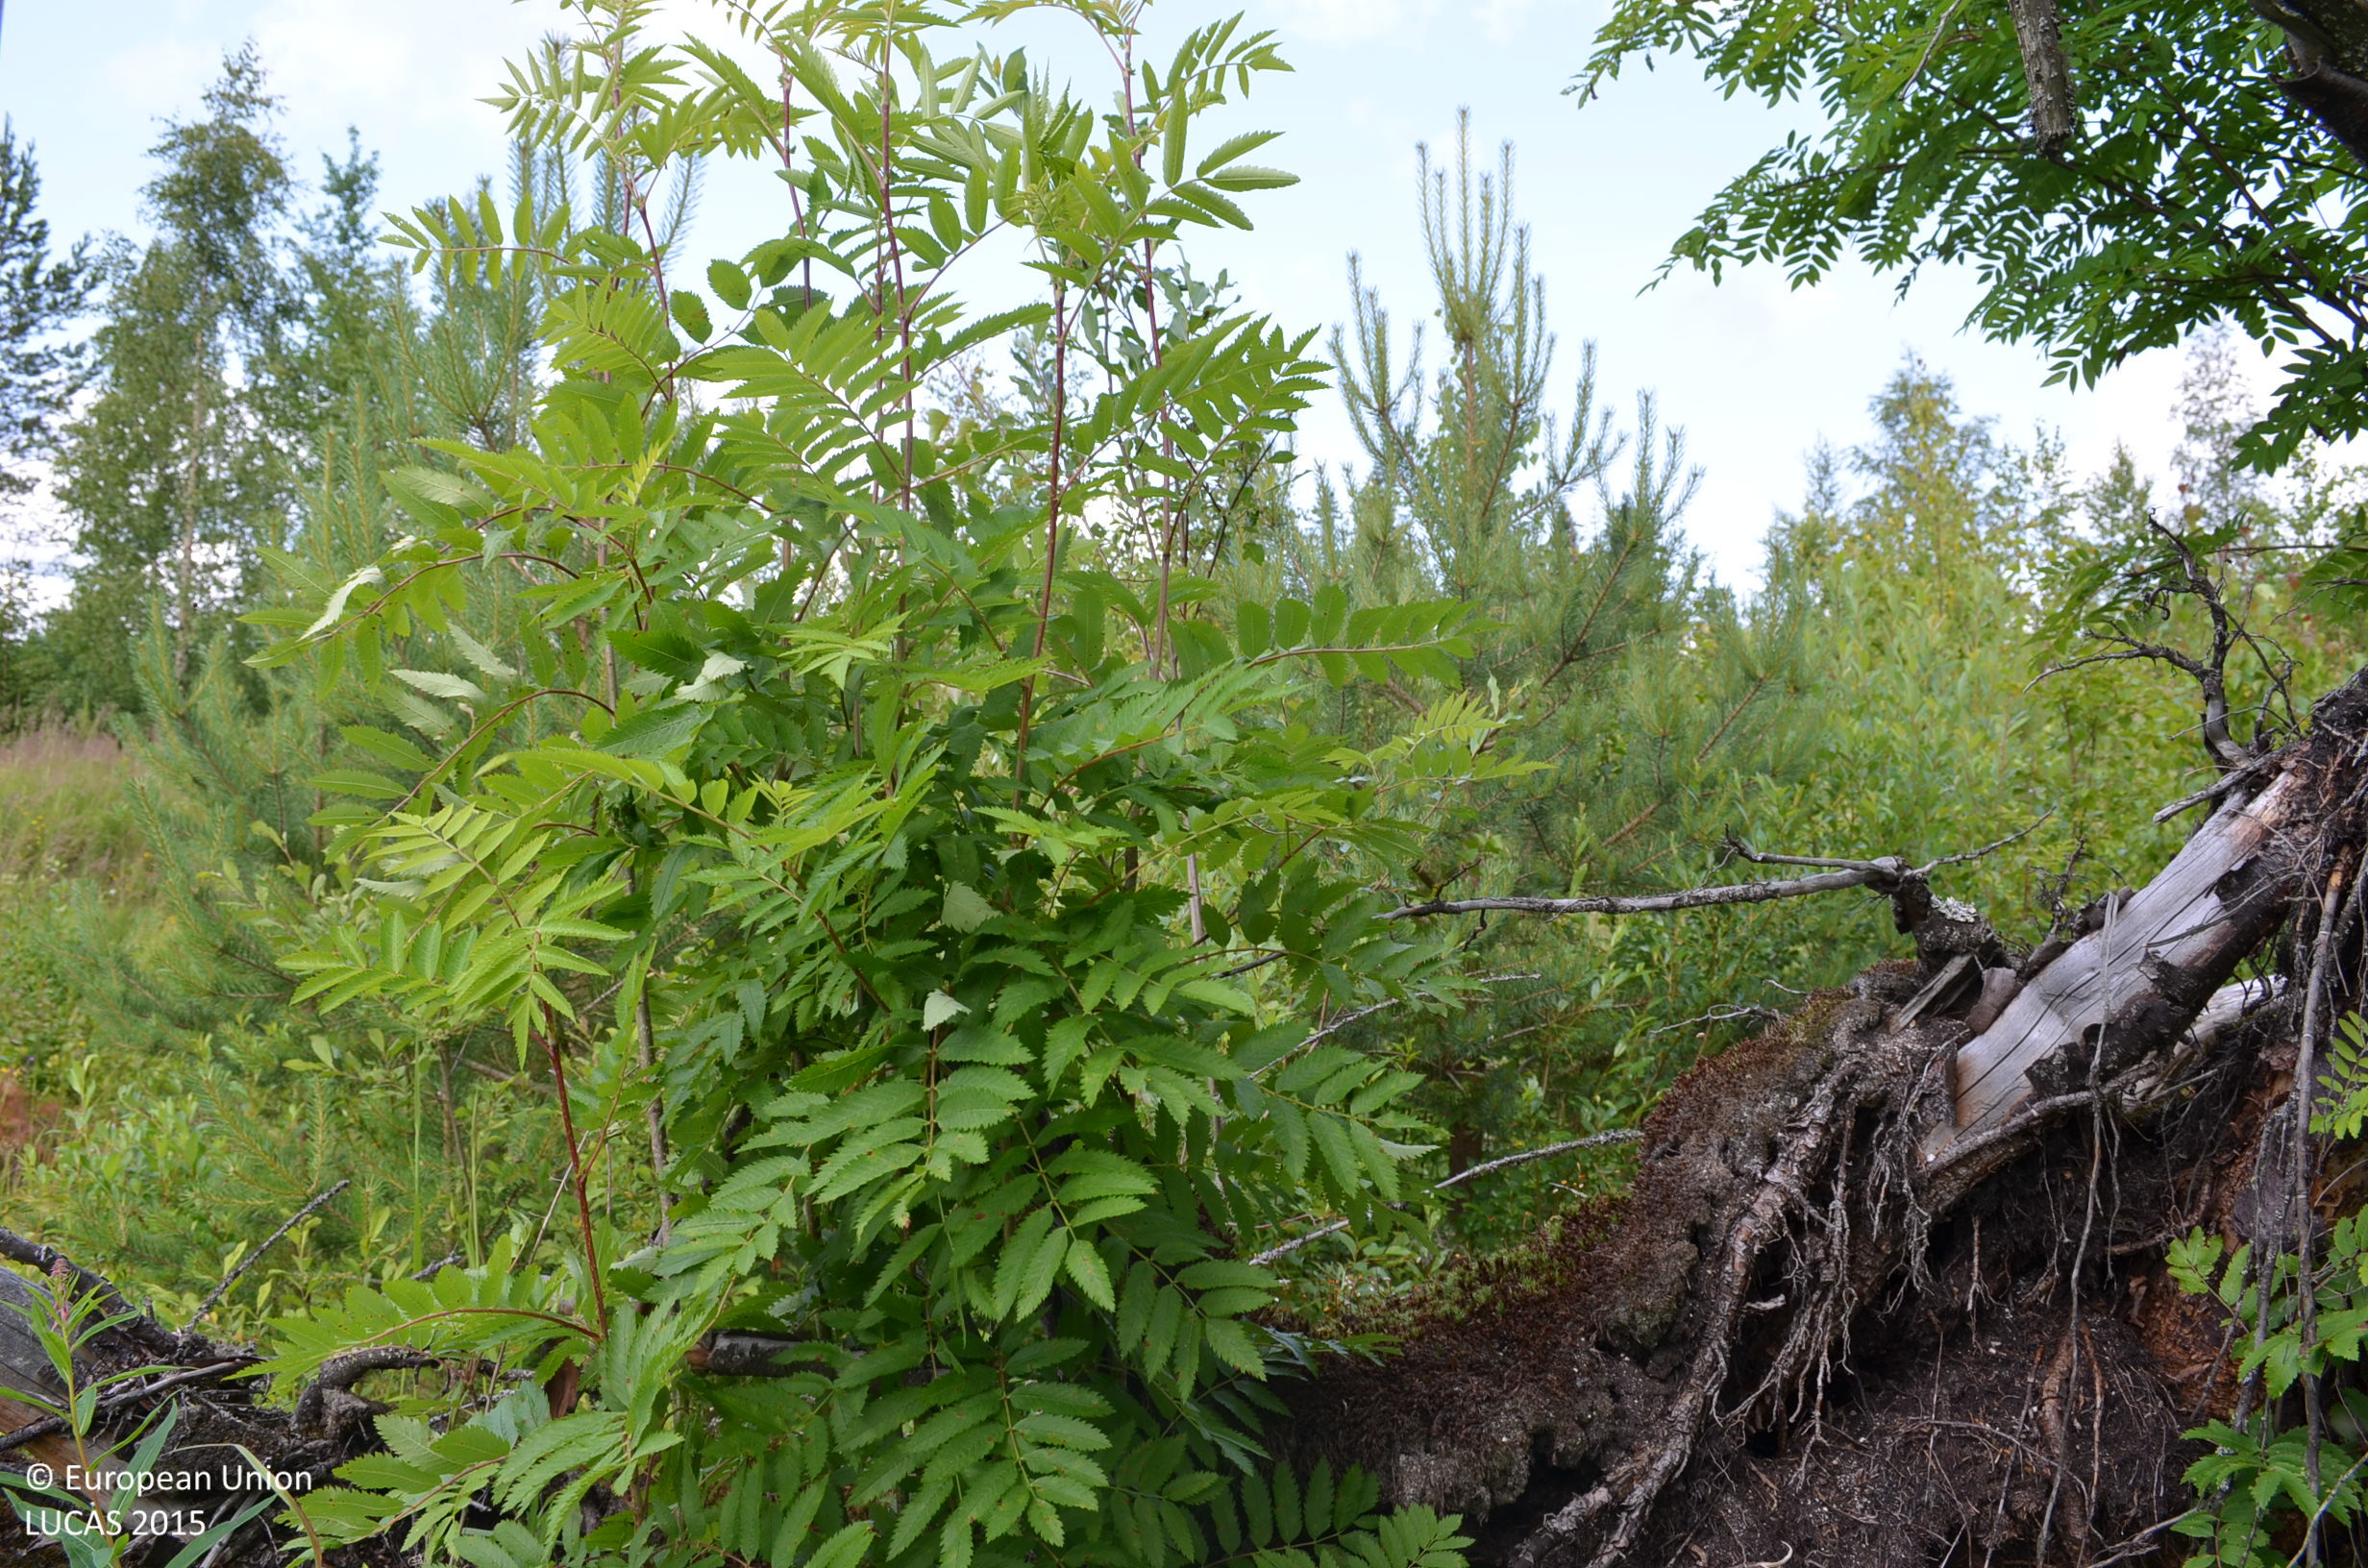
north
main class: Woodland
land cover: Broadleaved woodland
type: boreal forest
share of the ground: > 75 %
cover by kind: broadleaved forest trees 70 %, coniferous forest trees 15 %, herbaceous plants 10 %, shrubs 5 %
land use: Forestry
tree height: > 5 m
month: July
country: FI
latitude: 62.2124
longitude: 23.5922
